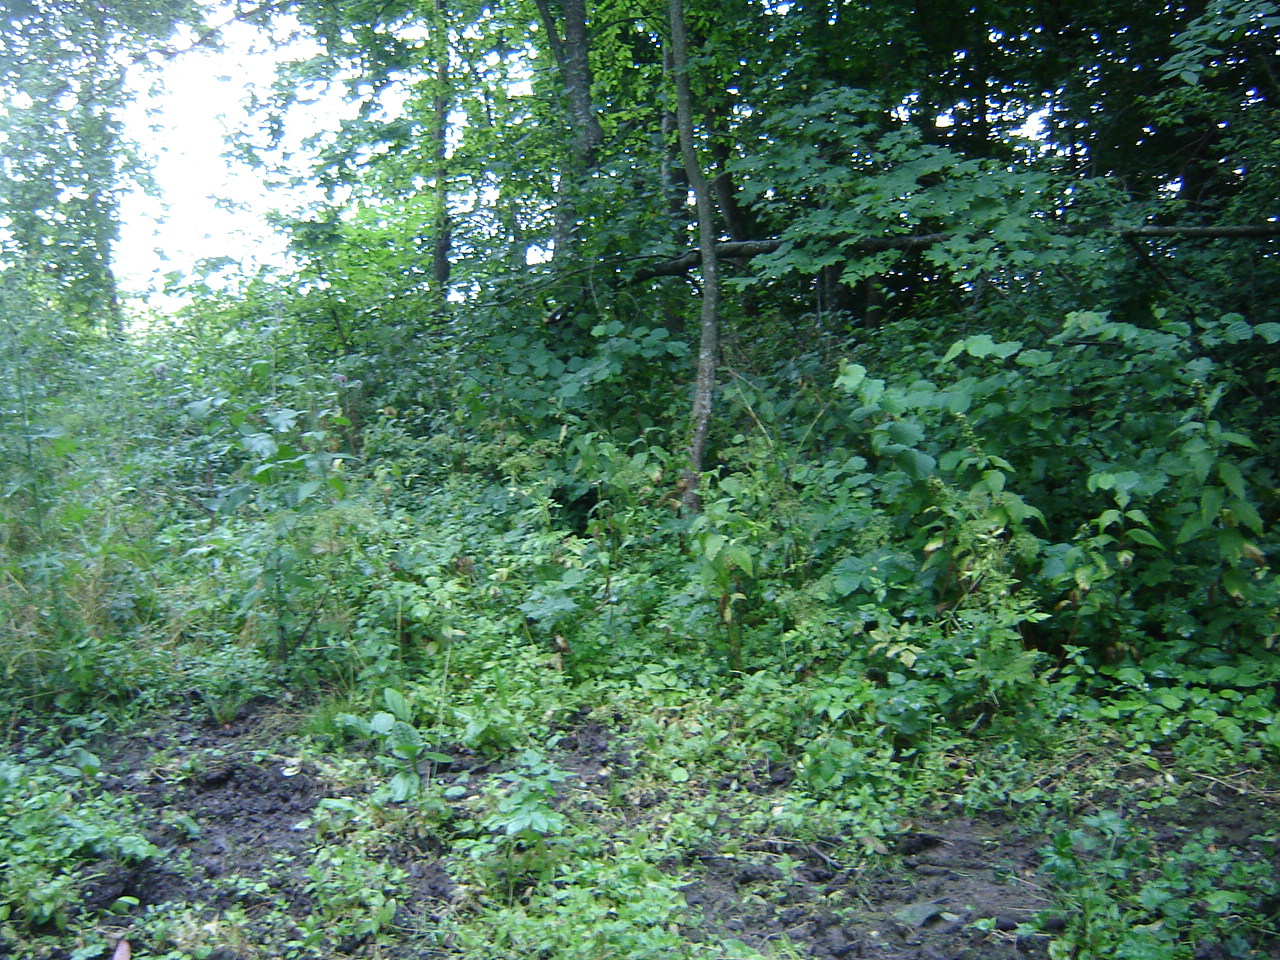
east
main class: Woodland
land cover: Broadleaved woodland
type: floodplain forest
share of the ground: > 75 %
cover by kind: broadleaved forest trees 80 %, herbaceous plants 15 %, shrubs 5 %
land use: Forestry
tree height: > 5 m
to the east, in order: Broadleaved woodland; Spontaneously vegetated surfaces; Rape and turnip rape
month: July
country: LT
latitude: 55.2641
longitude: 24.9834
